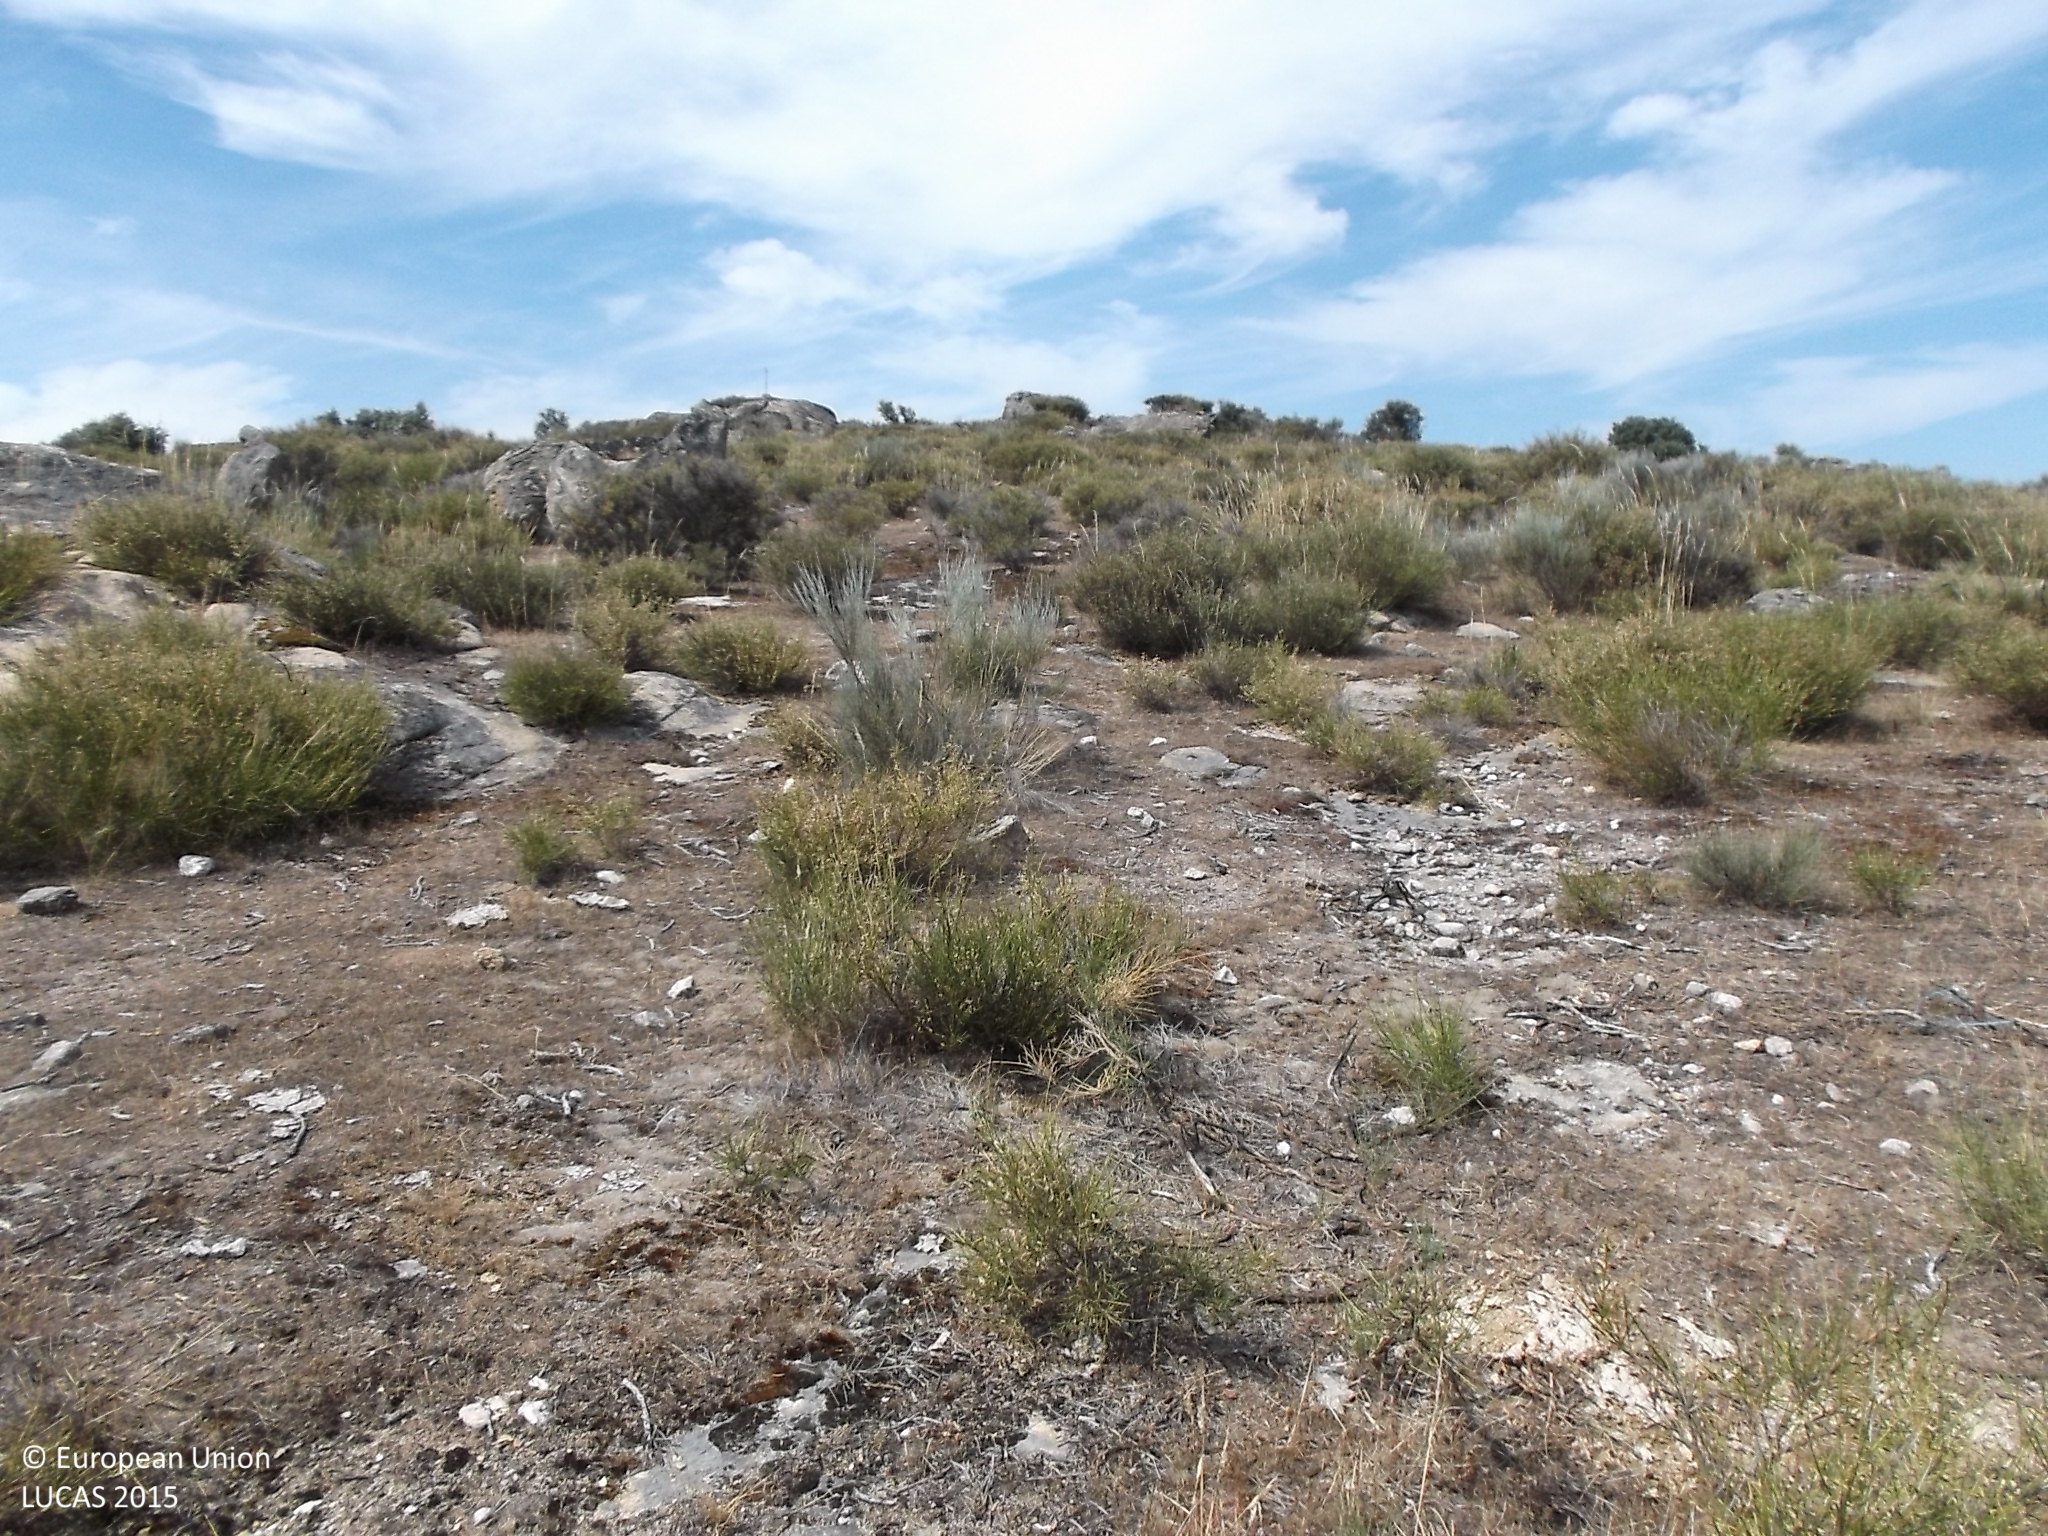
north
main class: Shrubland
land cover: Shrubland without tree cover
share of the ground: > 75 %
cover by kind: shrubs 100 %
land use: Agriculture (excluding fallow land and kitchen gardens)
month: July
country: ES
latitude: 40.9771
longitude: -6.8236
